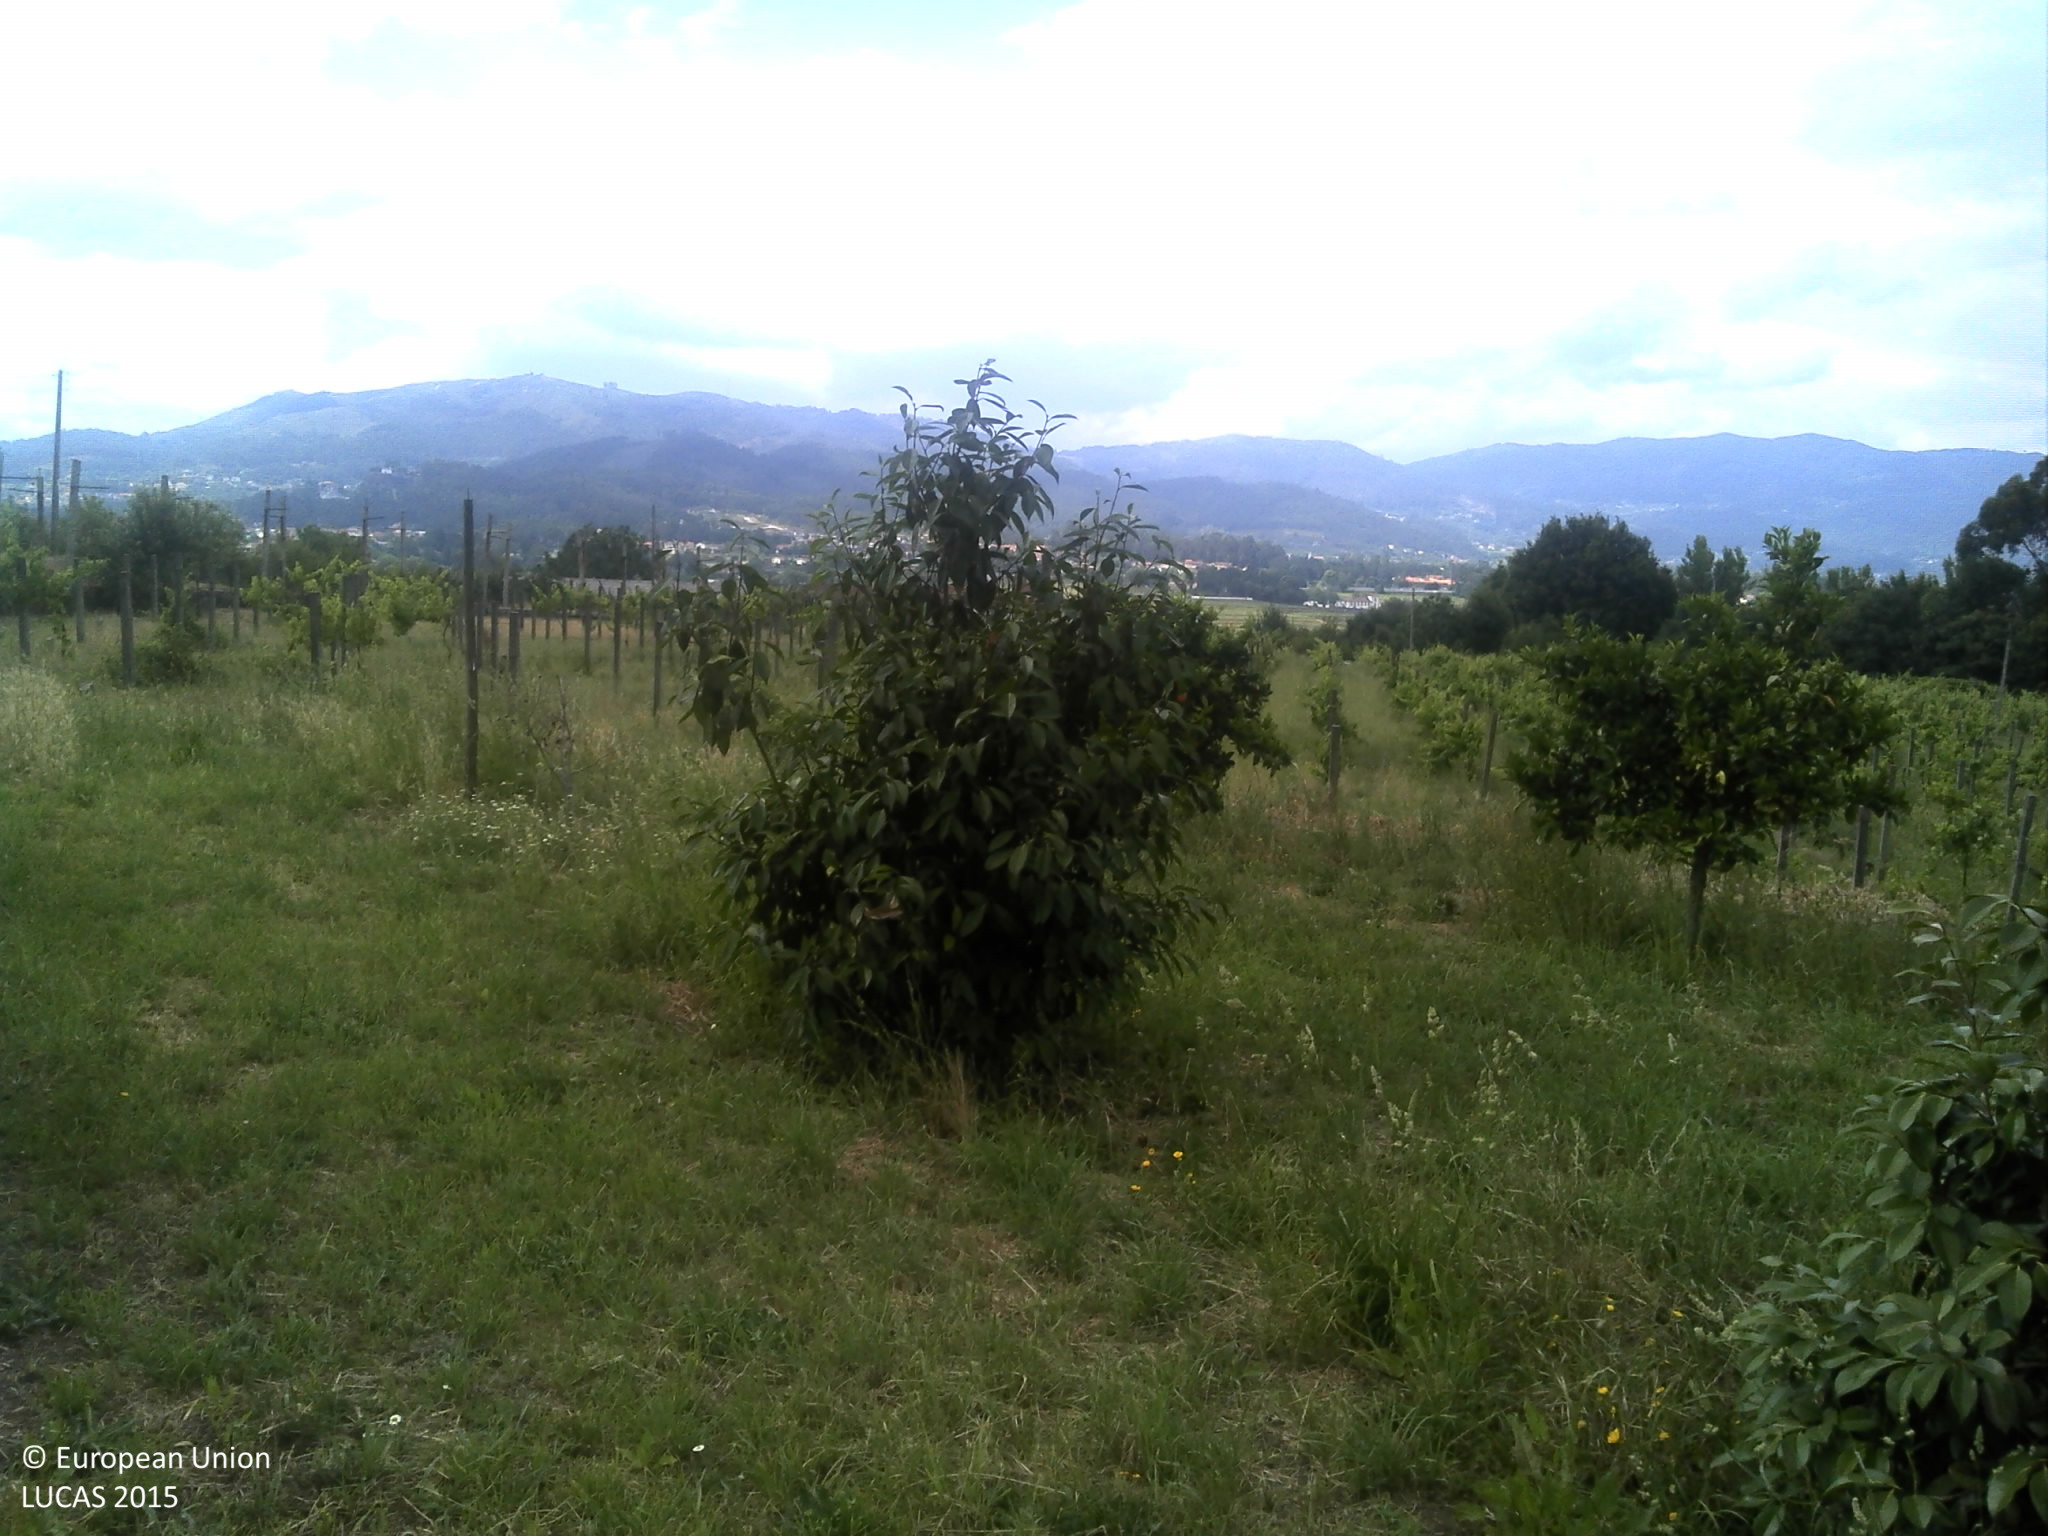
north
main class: Grassland
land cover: Grassland with sparse tree/shrub cover
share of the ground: 50 - 75 %
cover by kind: herbaceous plants 70 %, unconsolidated bare surface 20 %, broadleaved forest trees 5 %, shrubs 5 %
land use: Agriculture (excluding fallow land and kitchen gardens)
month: June
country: PT
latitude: 41.6104
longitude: -8.3319
